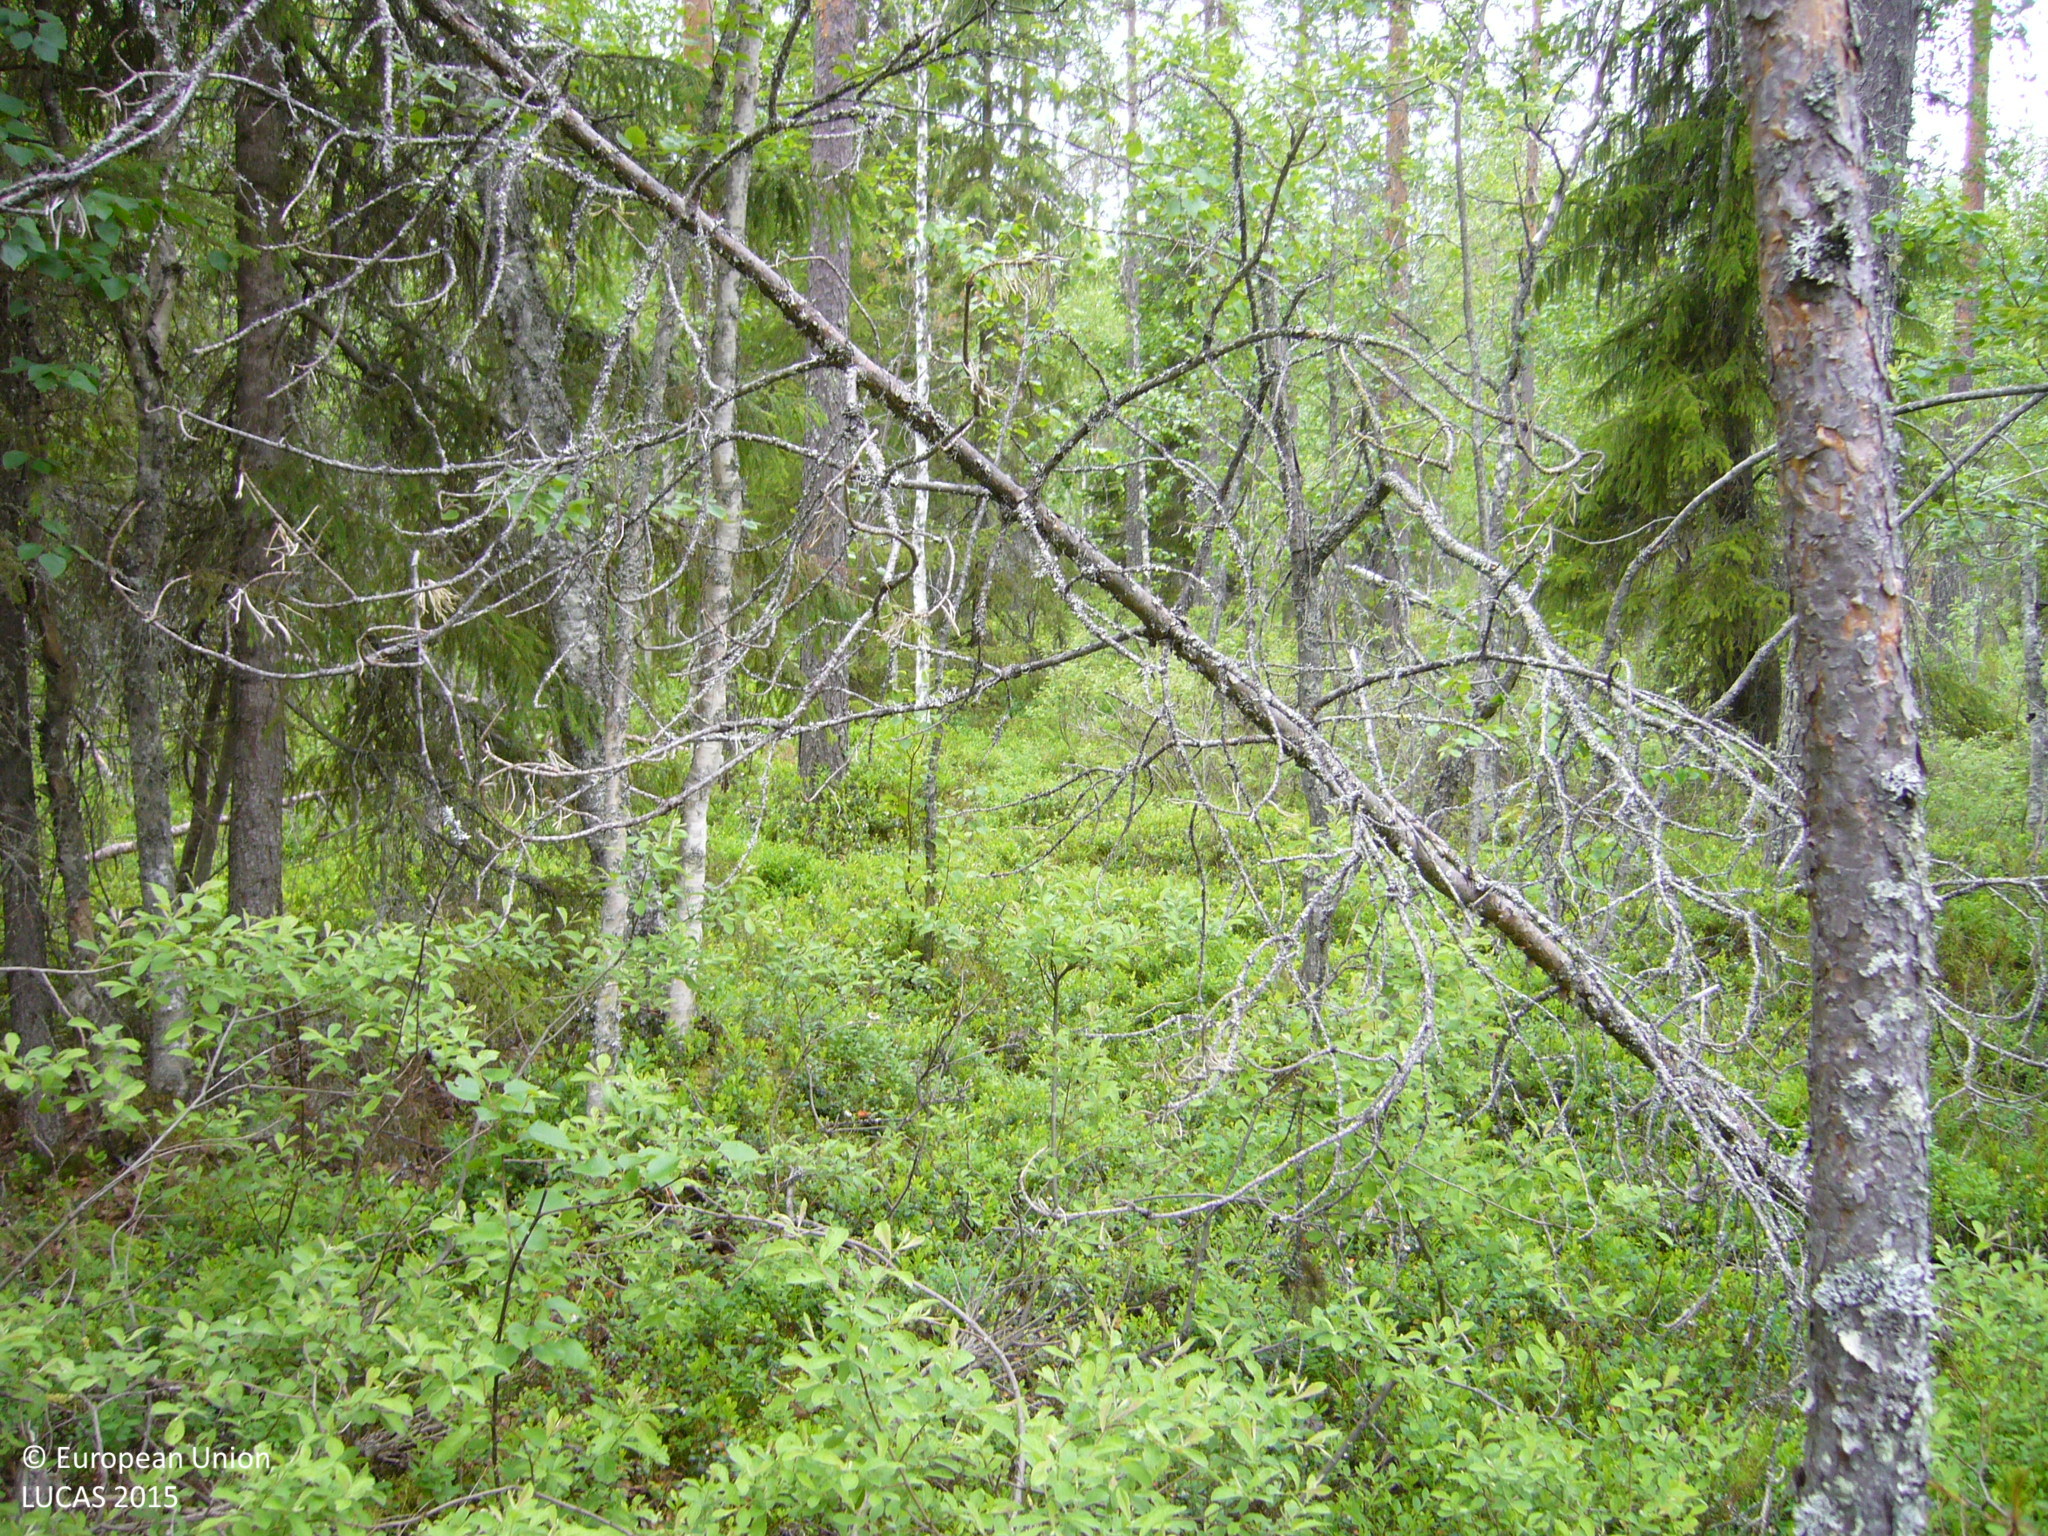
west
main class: Woodland
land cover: Pine dominated mixed woodland
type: boreal forest
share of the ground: 50 - 75 %
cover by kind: coniferous forest trees 40 %, shrubs 35 %, broadleaved forest trees 25 %
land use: Forestry
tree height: > 5 m
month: July
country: FI
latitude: 63.4338
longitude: 25.9662
